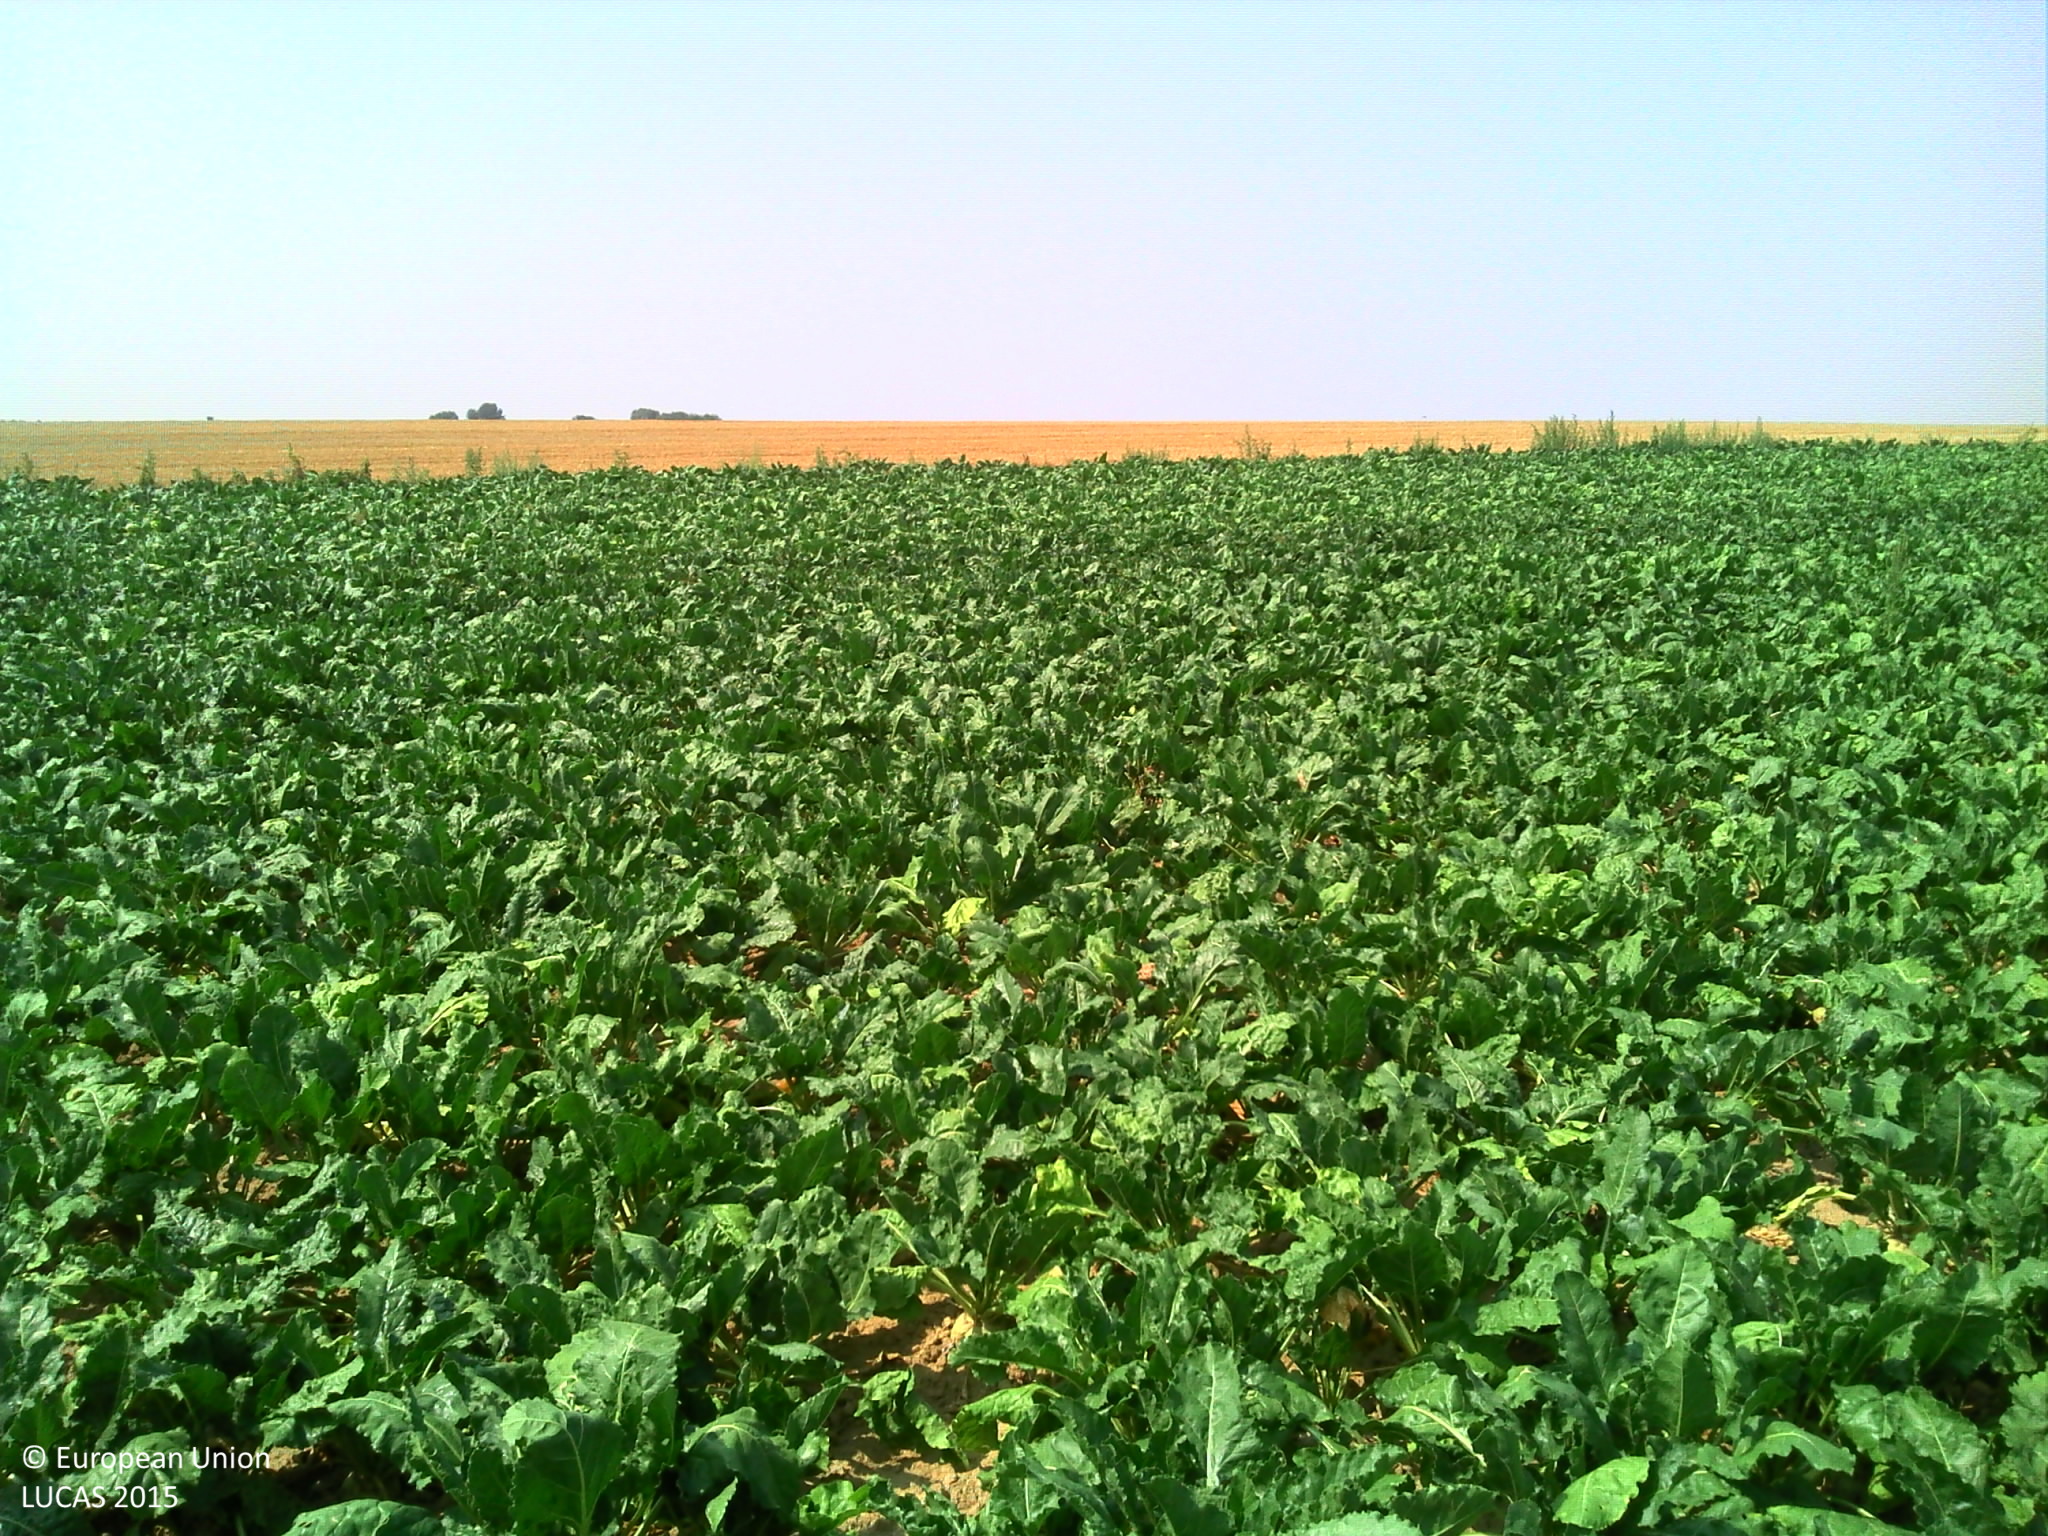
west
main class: Cropland
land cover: Sugar beet
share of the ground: > 75 %
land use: Agriculture (excluding fallow land and kitchen gardens)
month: August
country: FR
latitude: 49.0628
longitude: 2.9424
